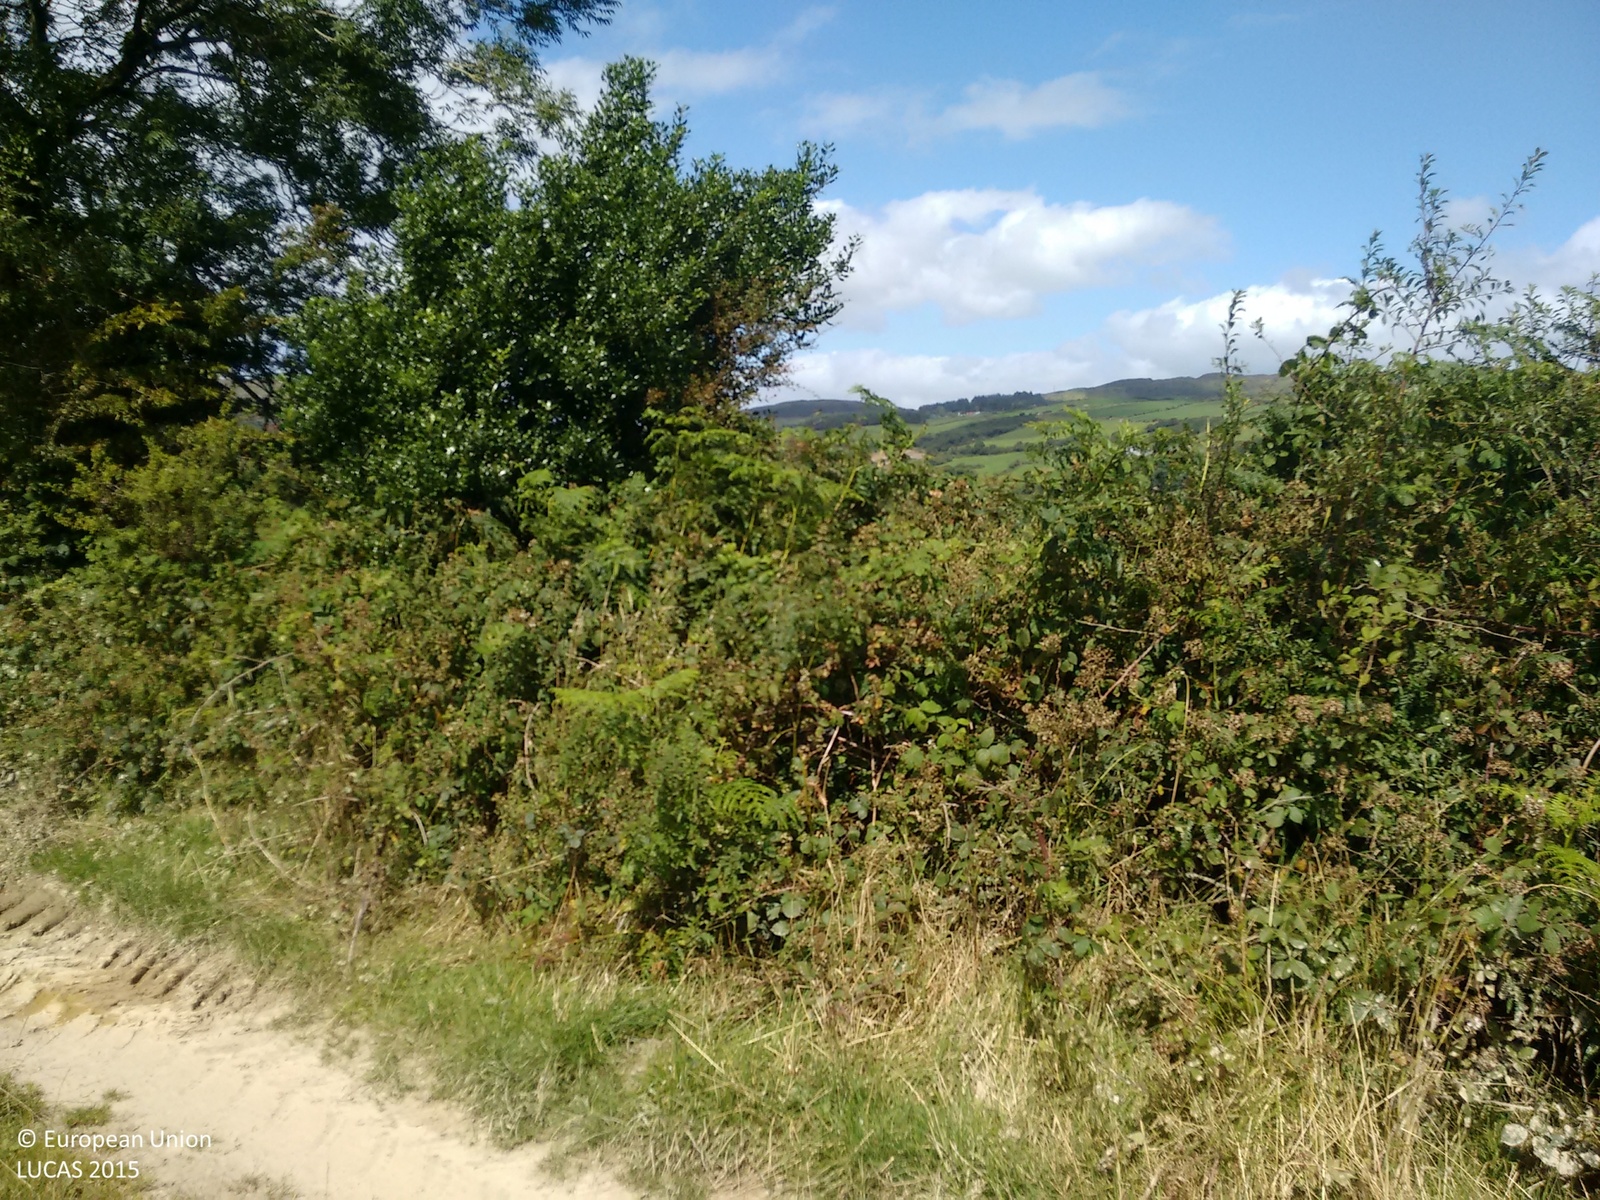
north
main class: Grassland
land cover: Grassland without tree/shrub cover
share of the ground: > 75 %
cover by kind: herbaceous plants 90 %, shrubs 5 %, unconsolidated bare surface 5 %
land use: Agriculture (excluding fallow land and kitchen gardens)
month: August
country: IE
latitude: 51.6514
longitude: -9.3487
